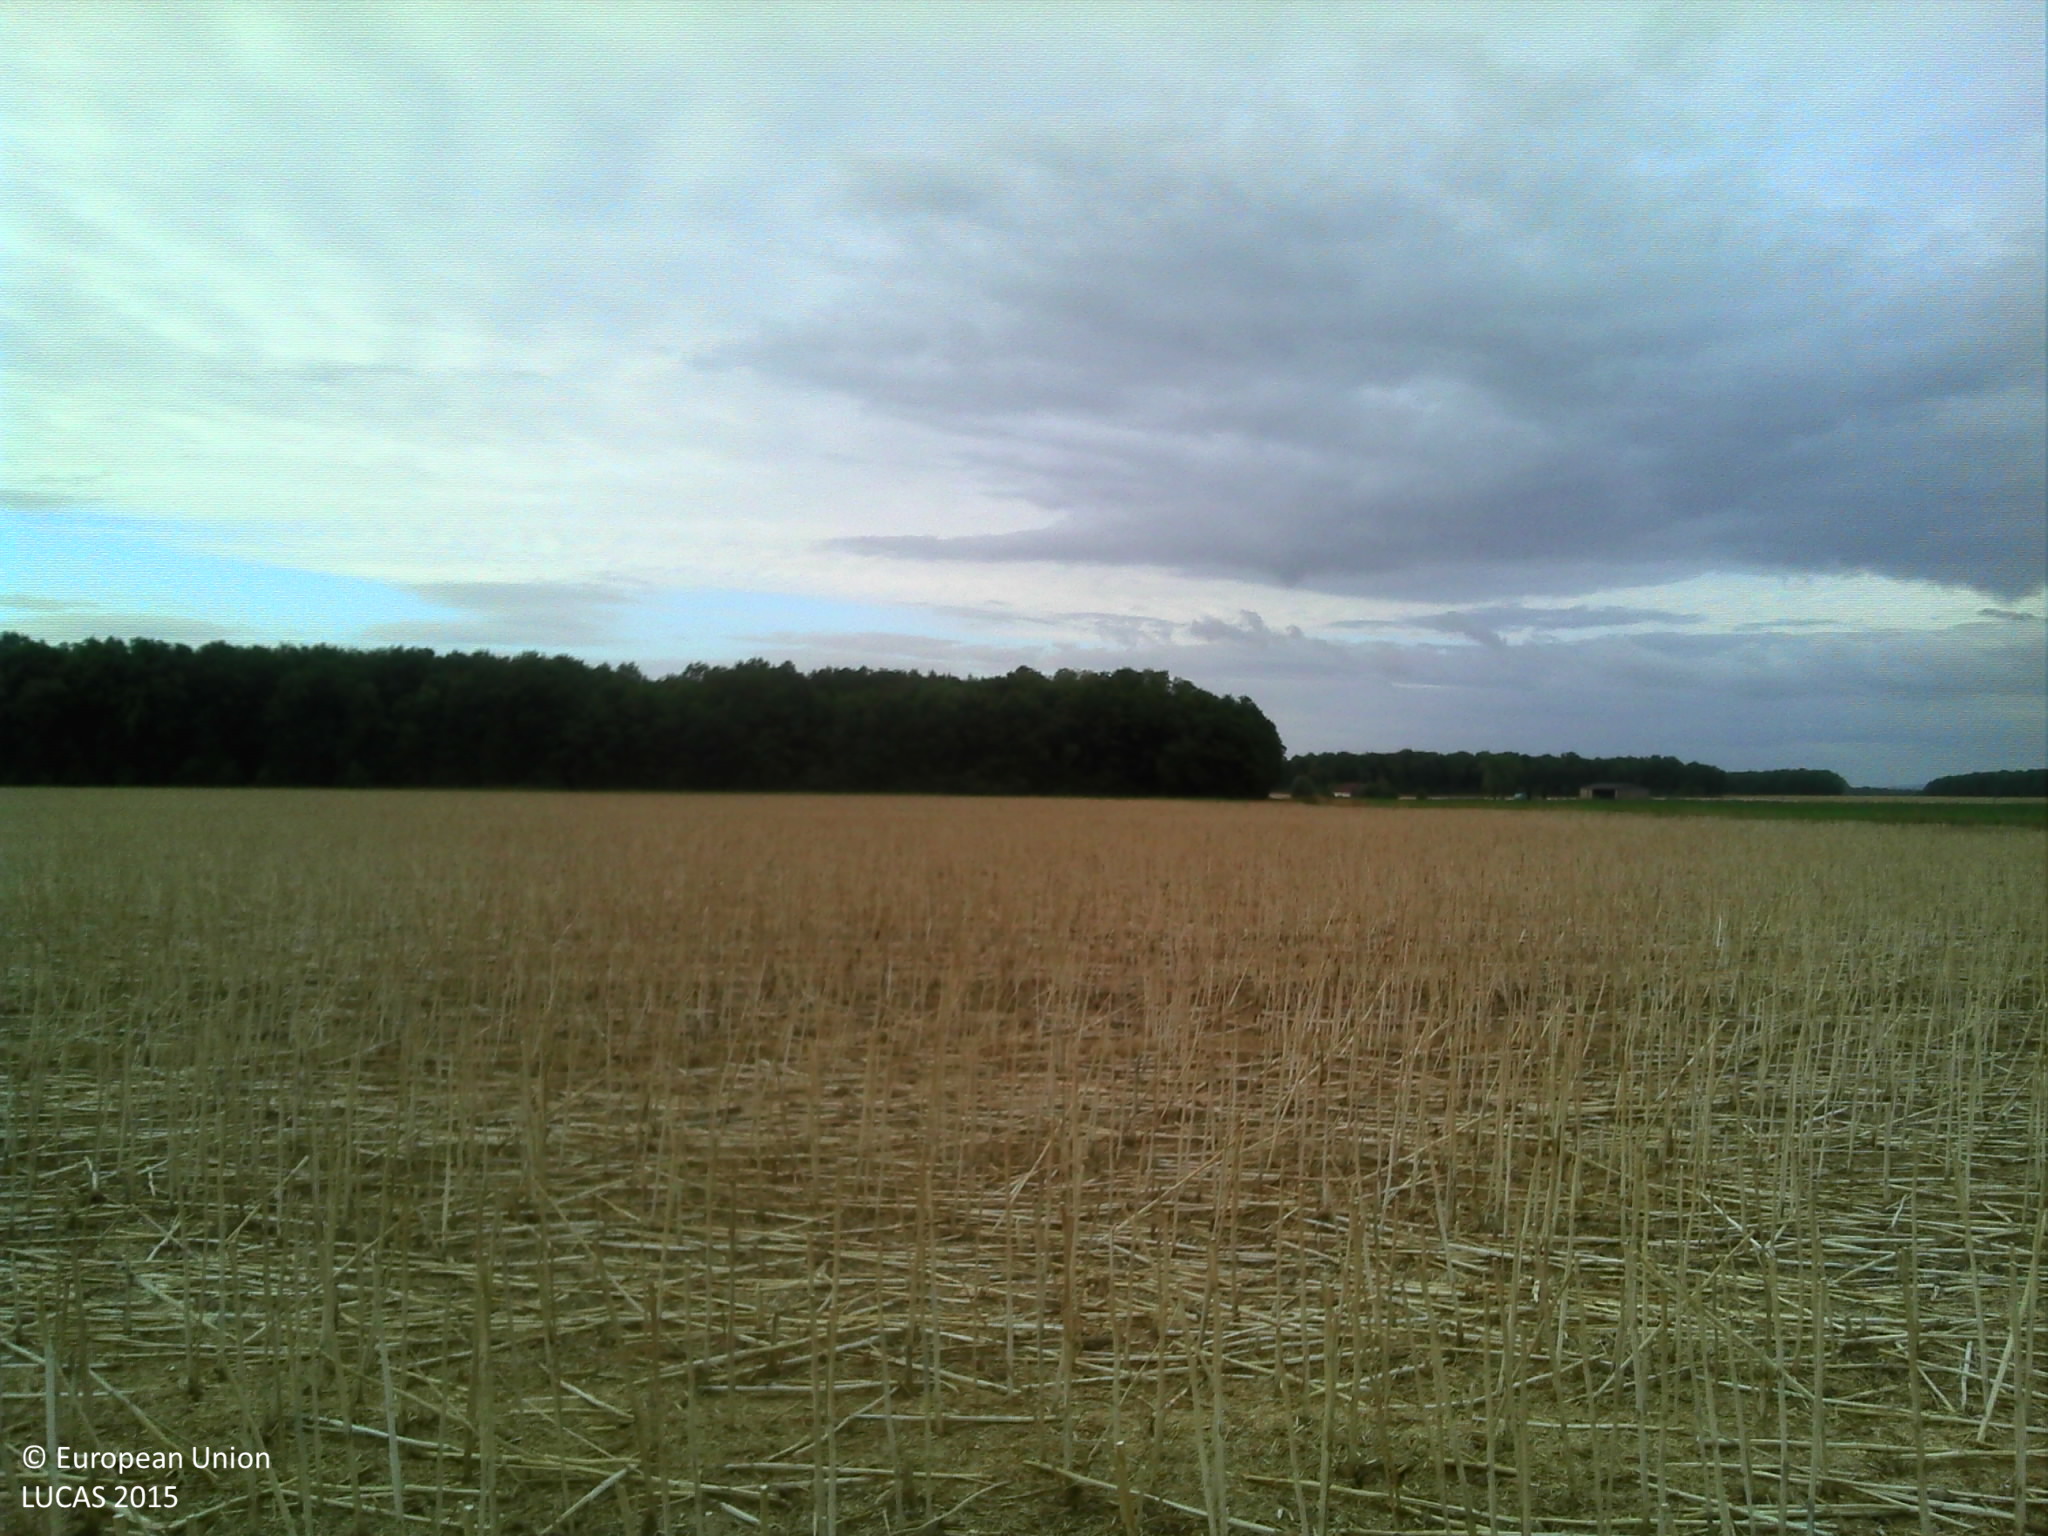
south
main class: Cropland
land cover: Rape and turnip rape
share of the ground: < 10 %
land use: Agriculture (excluding fallow land and kitchen gardens)
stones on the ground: < 10 %
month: July
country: FR
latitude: 46.8778
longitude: 4.8707
